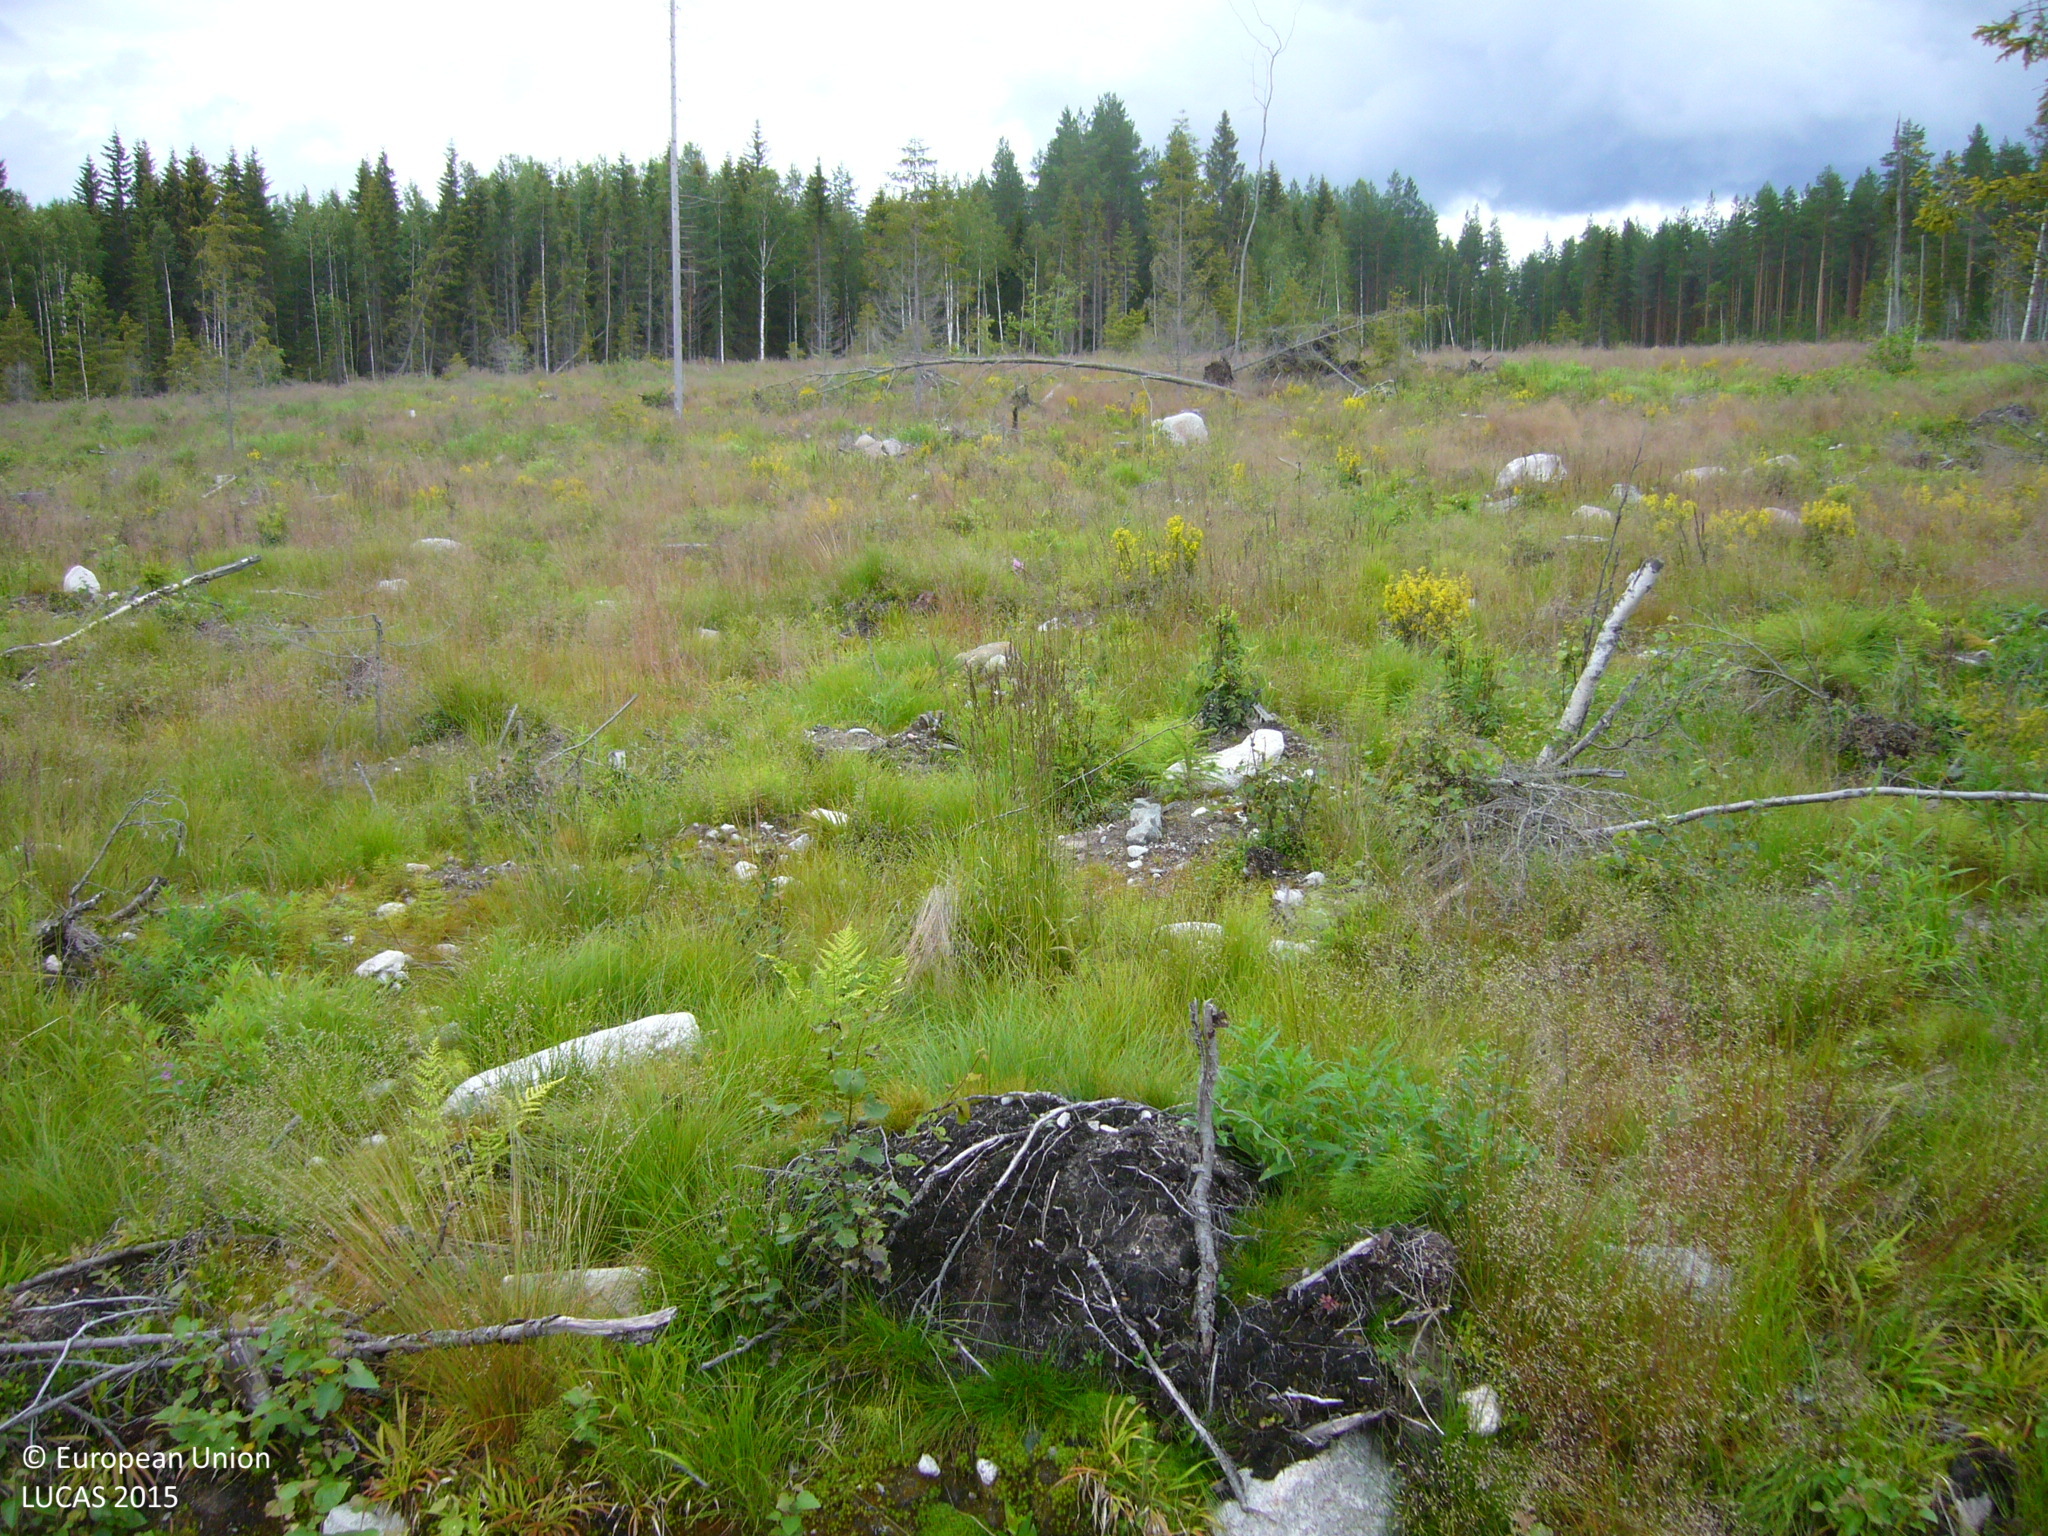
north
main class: Grassland
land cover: Grassland with sparse tree/shrub cover
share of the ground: > 75 %
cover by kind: herbaceous plants 50 %, consolidated bare surface 25 %, unconsolidated bare surface 20 %, coniferous forest trees 5 %
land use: Forestry
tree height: < 5 m
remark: Clear cut
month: July
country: FI
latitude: 64.0579
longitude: 26.1953
